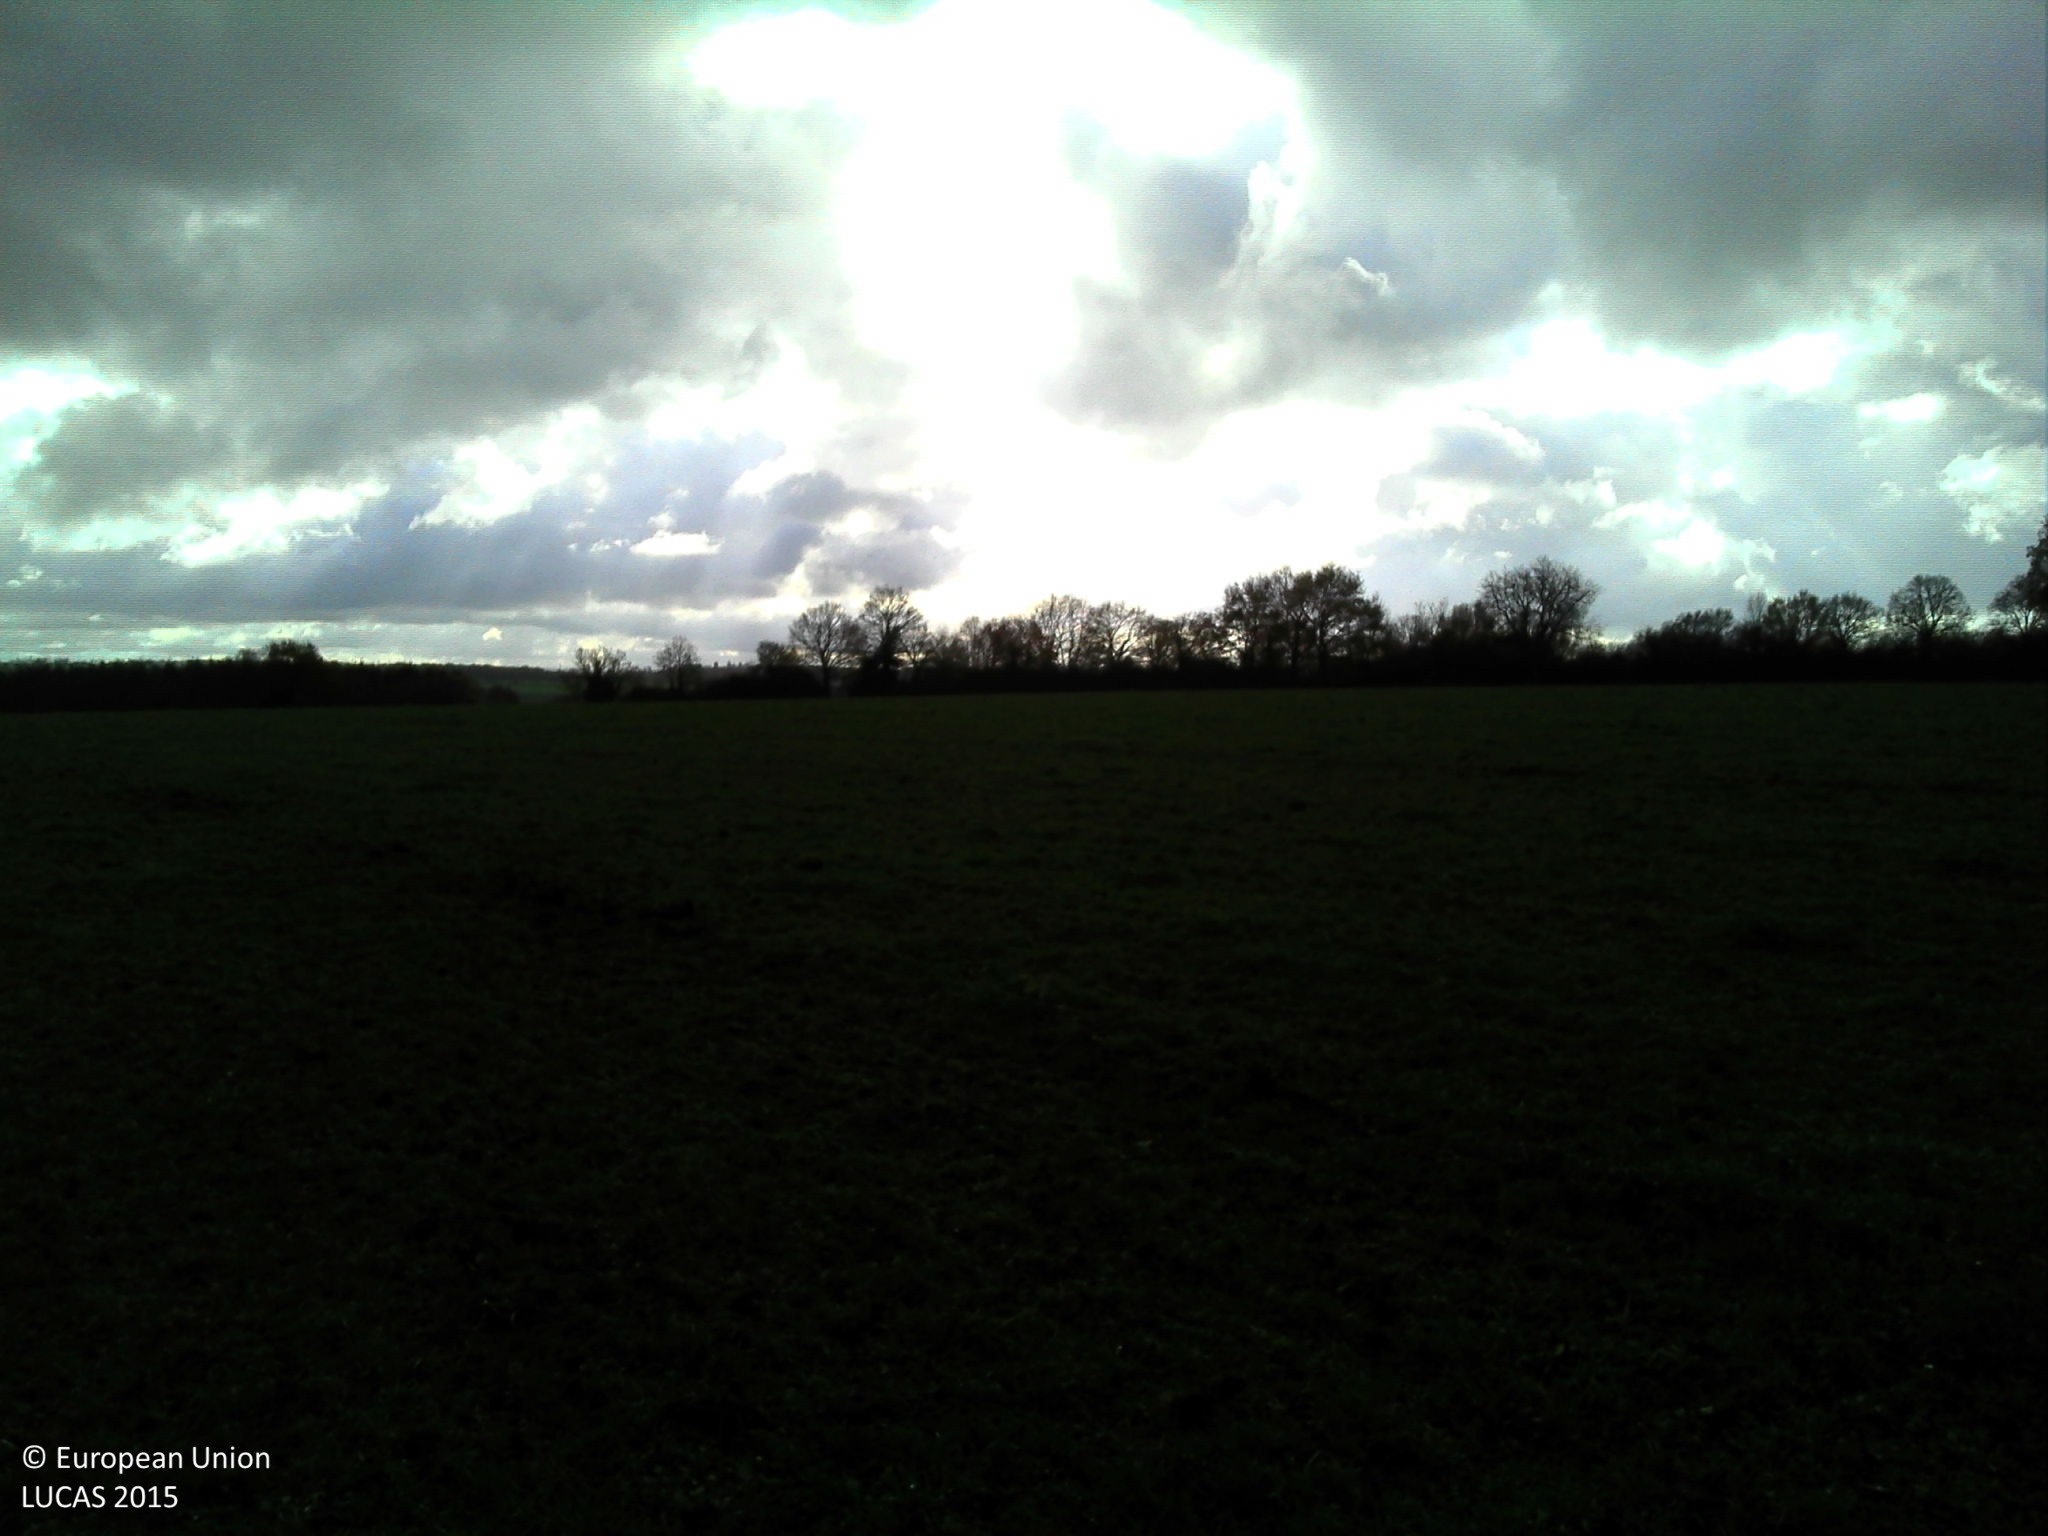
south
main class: Grassland
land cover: Grassland without tree/shrub cover
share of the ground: > 75 %
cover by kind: herbaceous plants 100 %
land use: Agriculture (excluding fallow land and kitchen gardens)
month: August
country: FR
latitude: 46.4310
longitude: 3.6096
